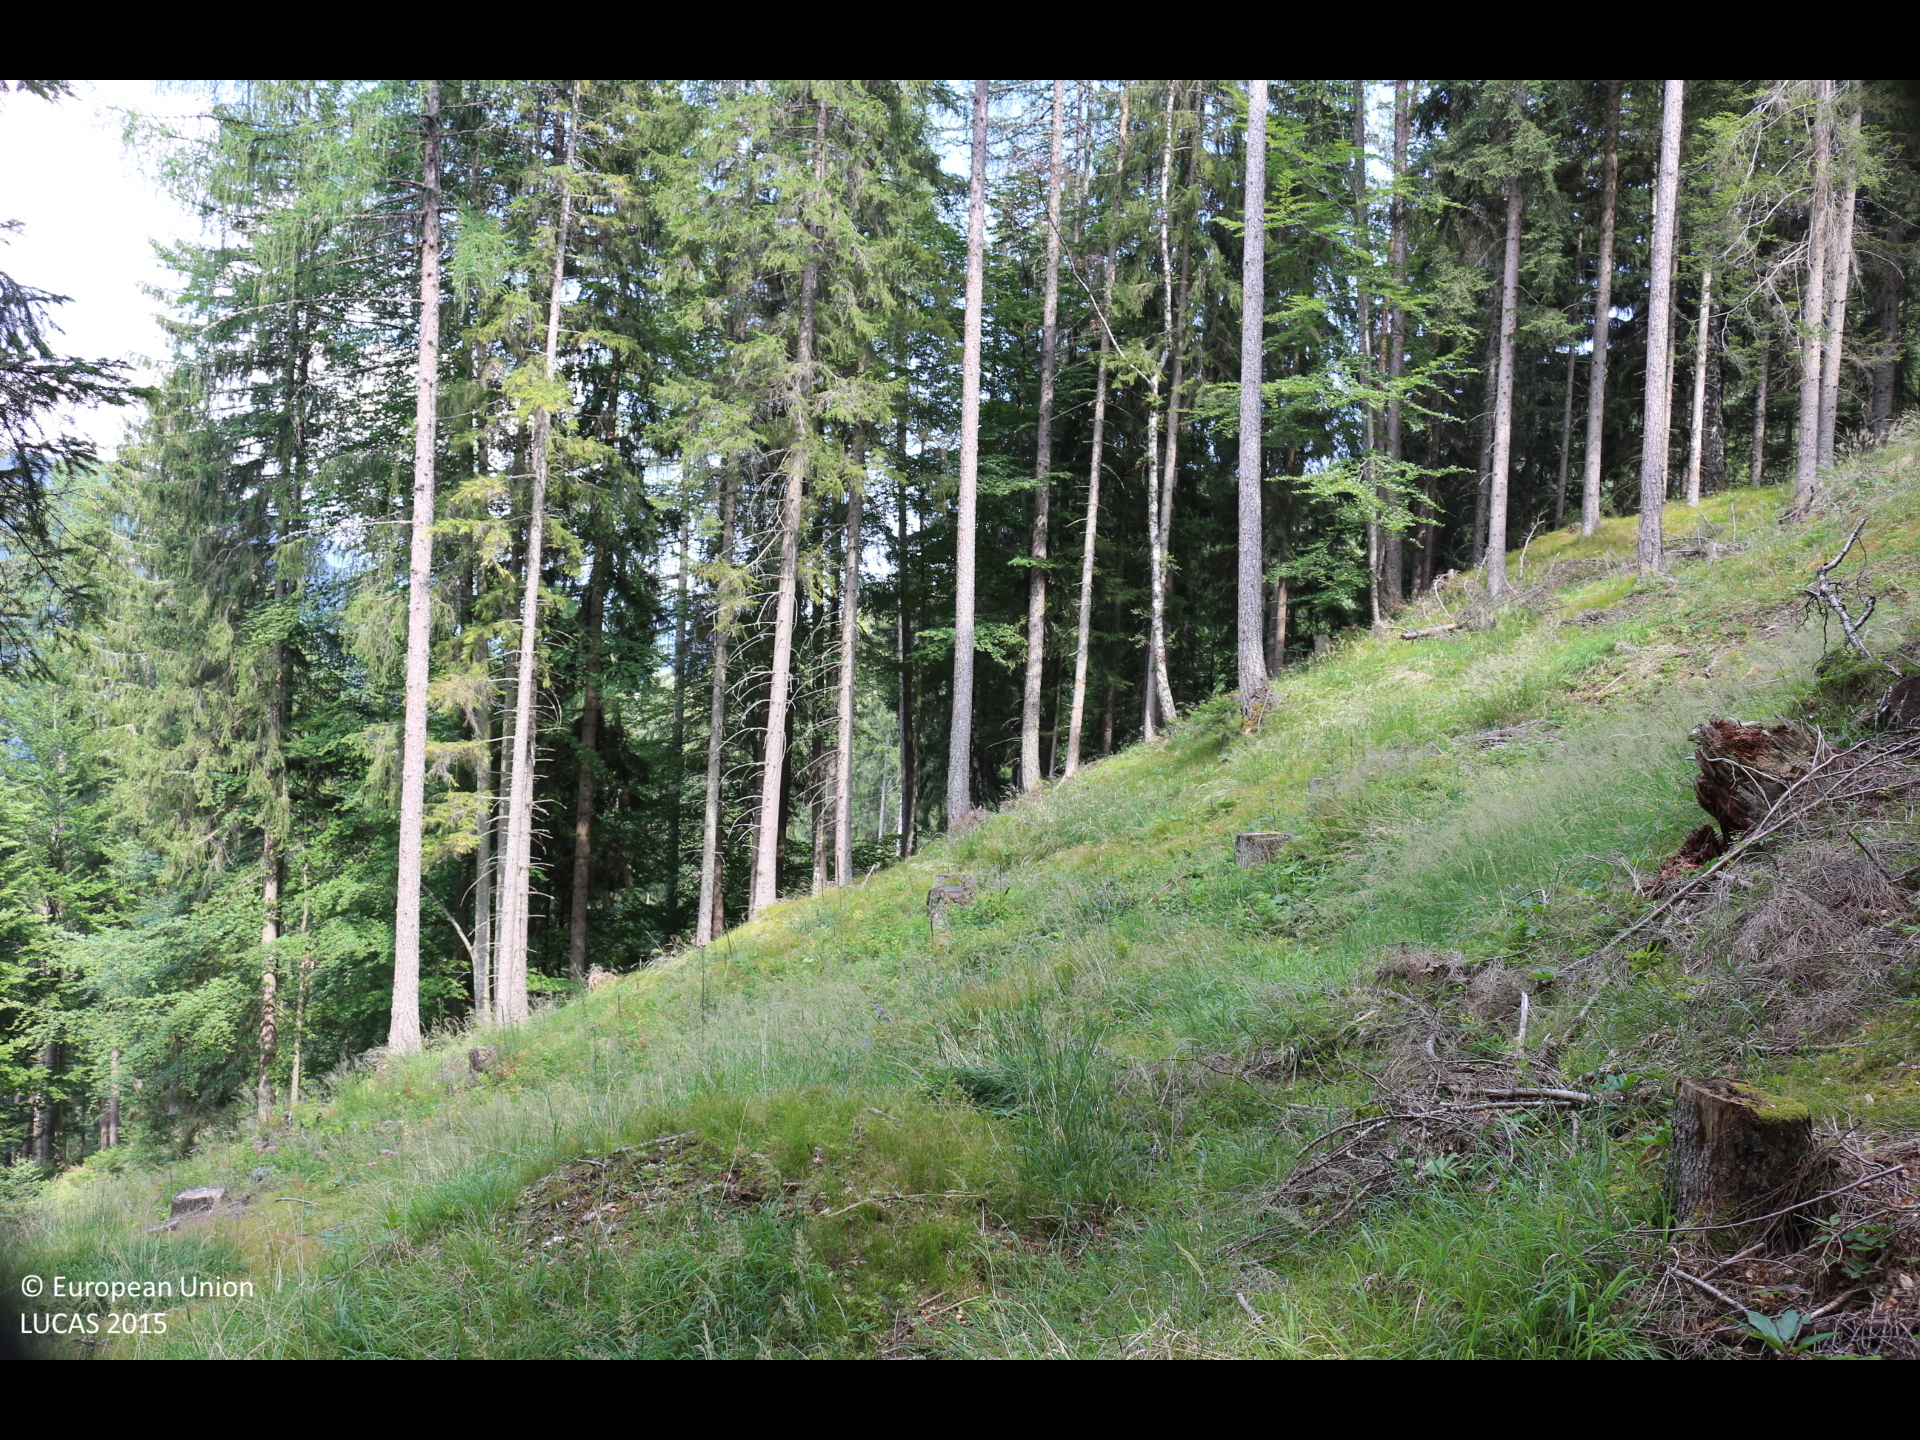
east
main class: Woodland
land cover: Spruce dominated coniferous woodland
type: alpine coniferous forest
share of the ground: > 75 %
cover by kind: coniferous forest trees 80 %, herbaceous plants 15 %, broadleaved forest trees 5 %
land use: Forestry
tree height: > 5 m
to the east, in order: Spruce dominated coniferous woodland; Spontaneously vegetated surfaces; Other coniferous woodland; Tracks; Spontaneously vegetated surfaces; Spruce dominated coniferous woodland; Other mixed woodland; Spruce dominated mixed woodland
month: July
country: AT
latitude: 46.6489
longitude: 13.6687
